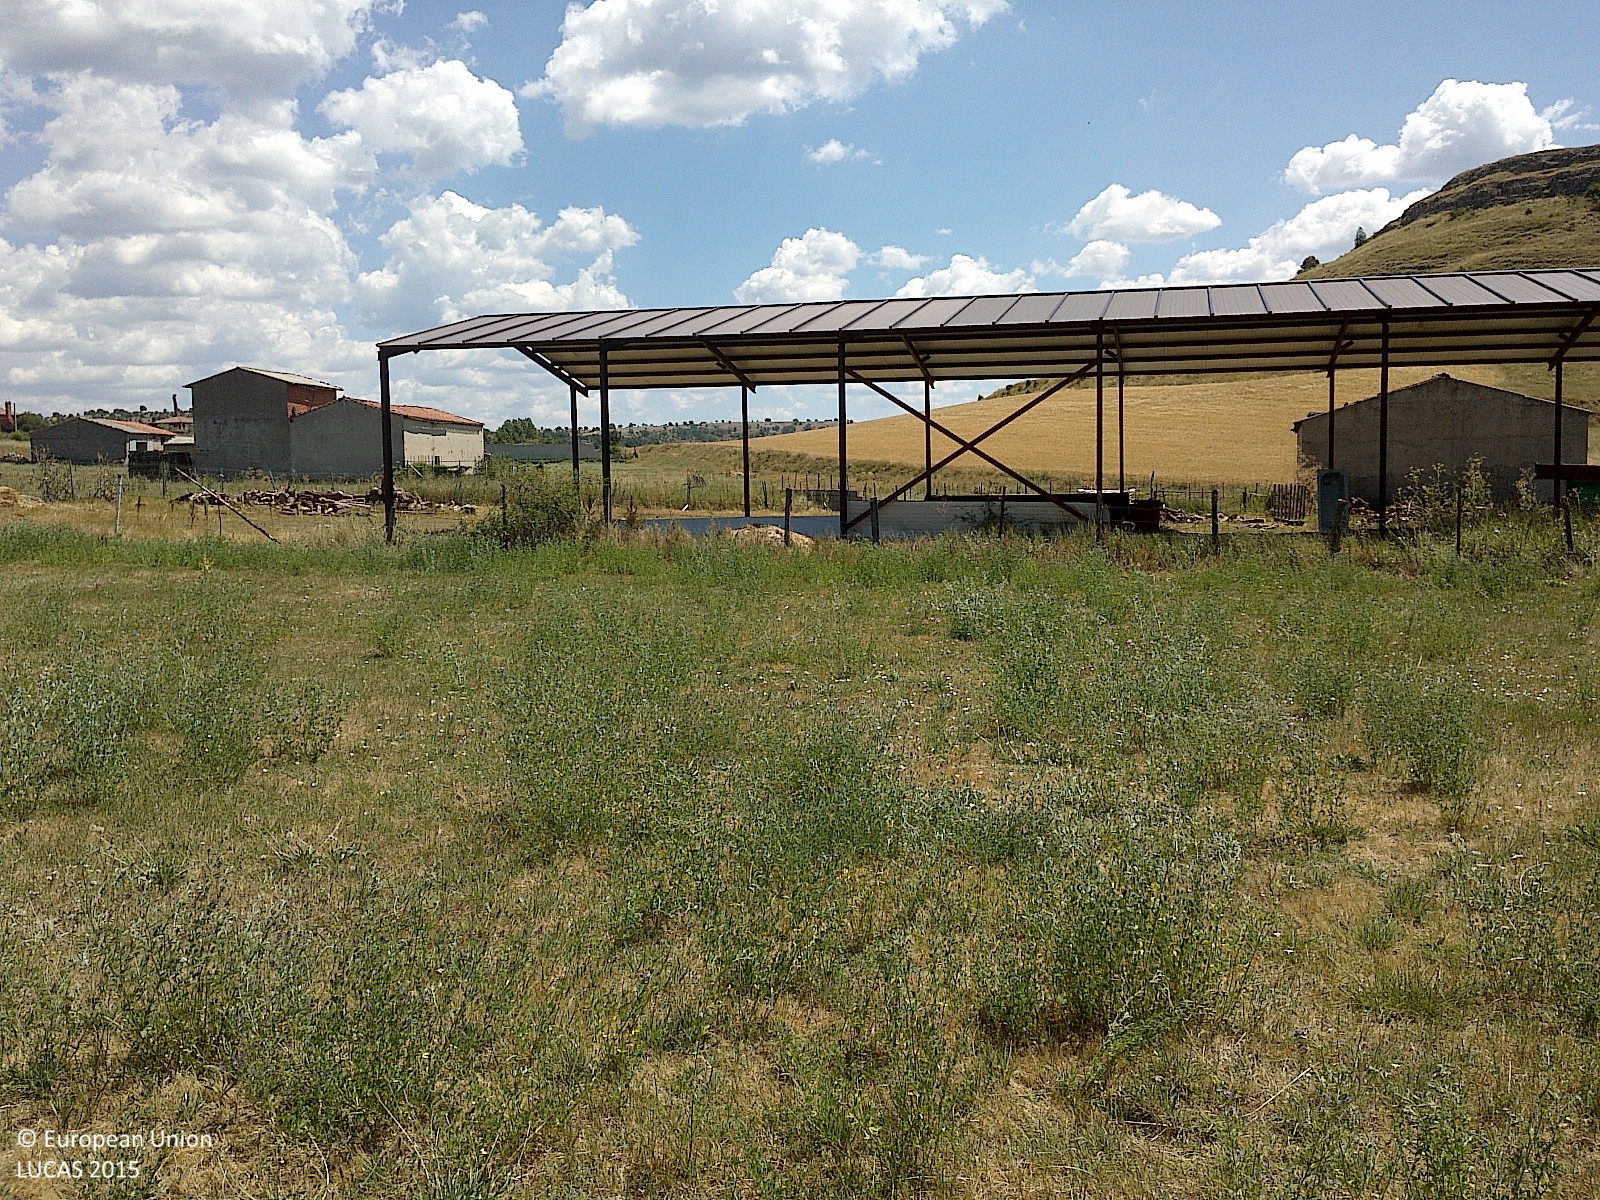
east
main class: Grassland
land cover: Grassland without tree/shrub cover
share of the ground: > 75 %
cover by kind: herbaceous plants 100 %
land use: Semi-natural and natural areas not in use
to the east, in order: Grassland without tree/shrub cover; Fences; Spontaneously vegetated surfaces; Artificial constructions in urban areas; Grassland without tree/shrub cover; Fences; Spontaneously vegetated surfaces; Fences; Spontaneously vegetated surfaces; Tracks; Grass margins; Barley; Common wheat
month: July
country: ES
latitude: 41.8456
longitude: -3.1631
